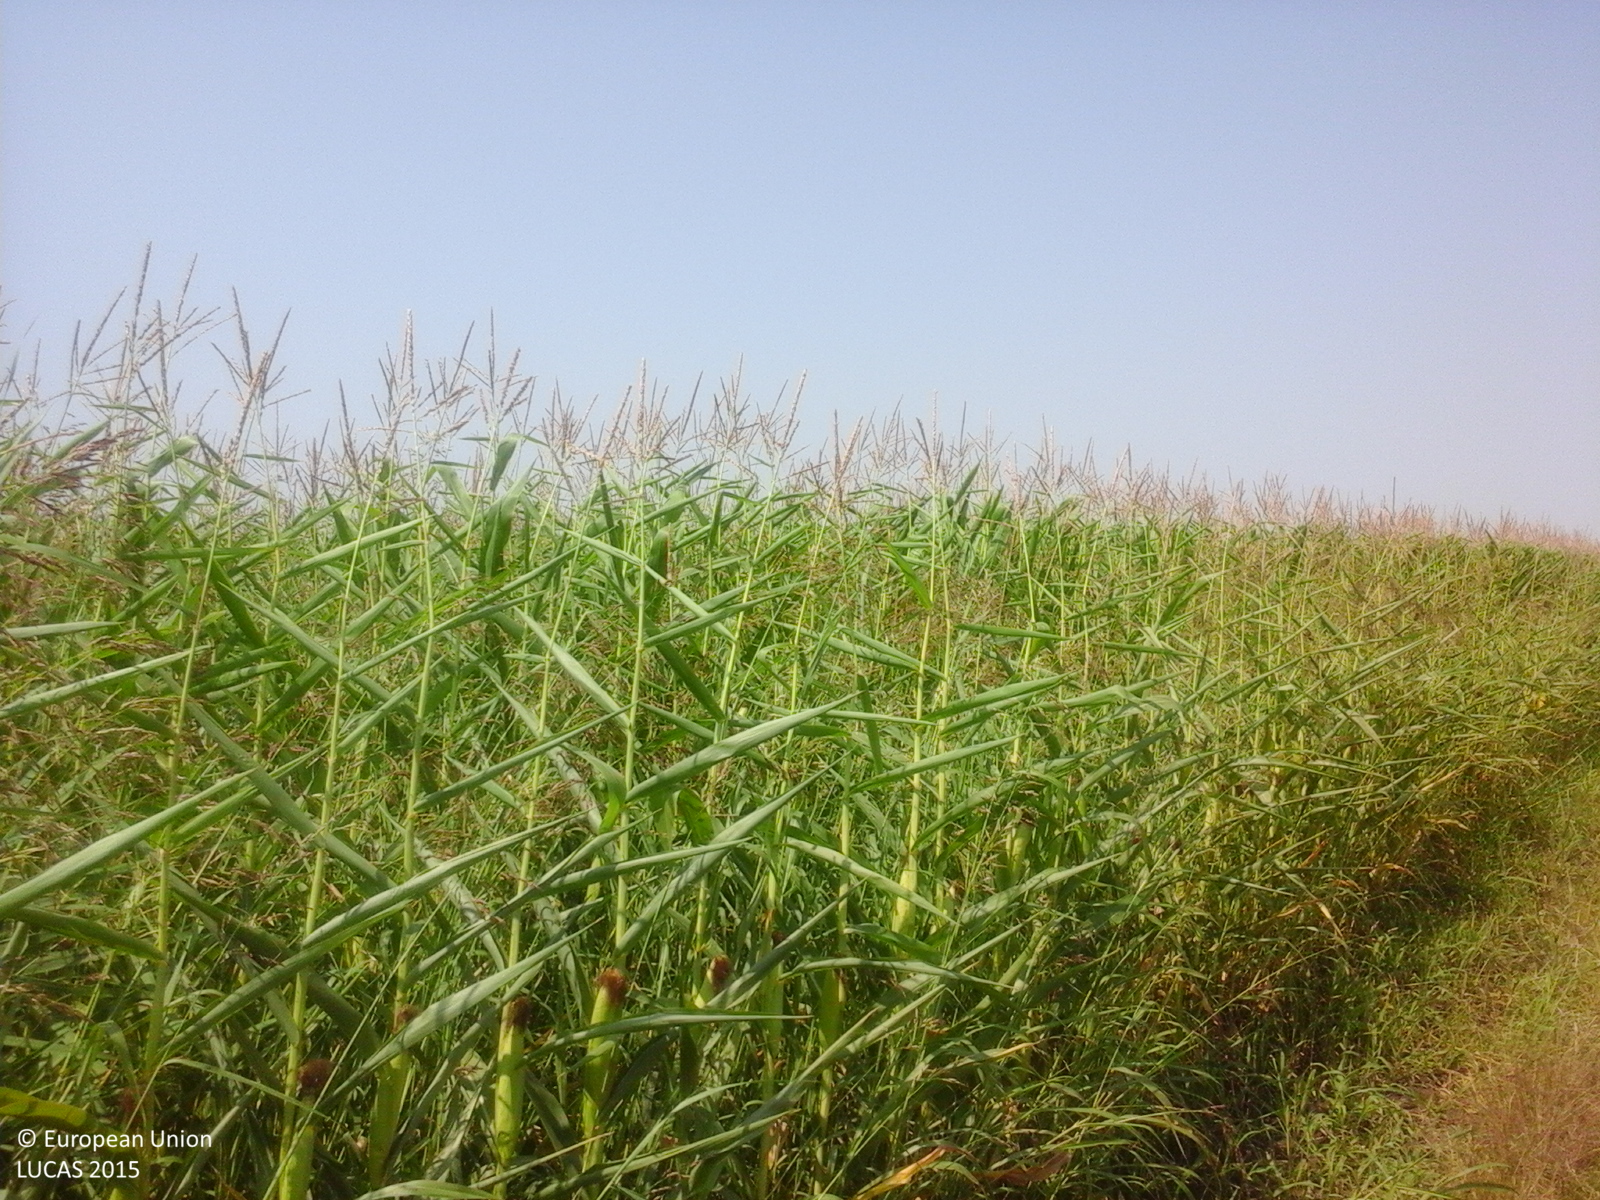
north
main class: Cropland
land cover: Maize
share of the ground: > 75 %
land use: Agriculture (excluding fallow land and kitchen gardens)
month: July
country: RO
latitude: 44.8114
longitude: 26.7789
